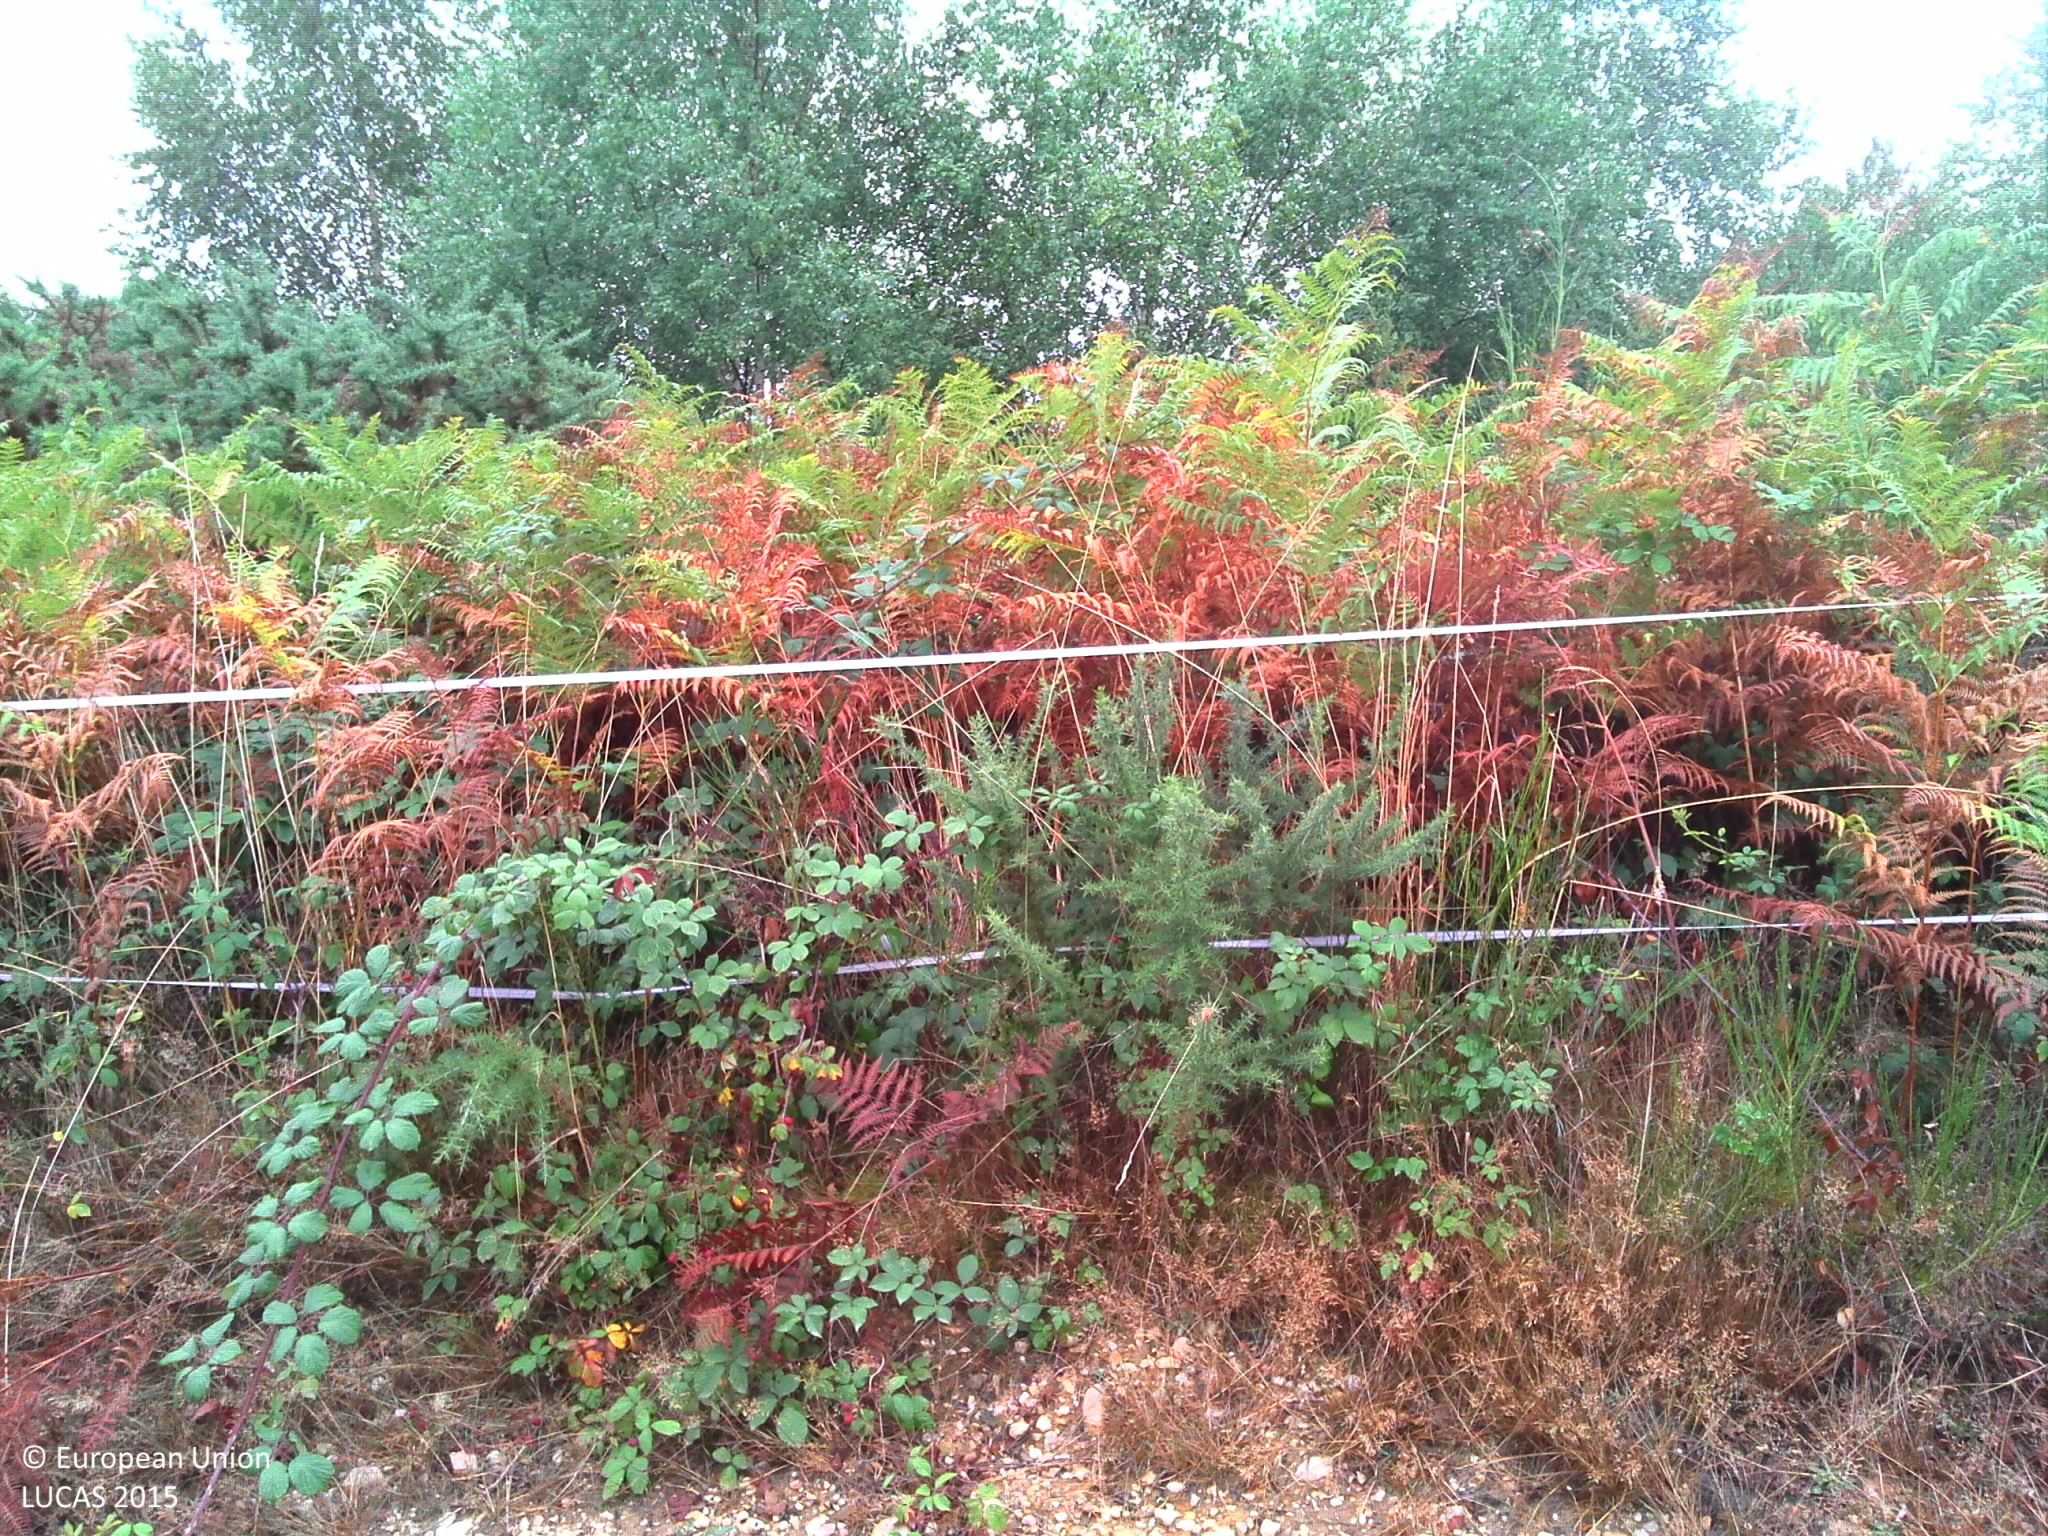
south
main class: Grassland
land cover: Grassland without tree/shrub cover
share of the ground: > 75 %
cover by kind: herbaceous plants 80 %, lichens and mosses 10 %, unconsolidated bare surface 10 %
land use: Agriculture (excluding fallow land and kitchen gardens)
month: August
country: FR
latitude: 45.5038
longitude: 1.0447
